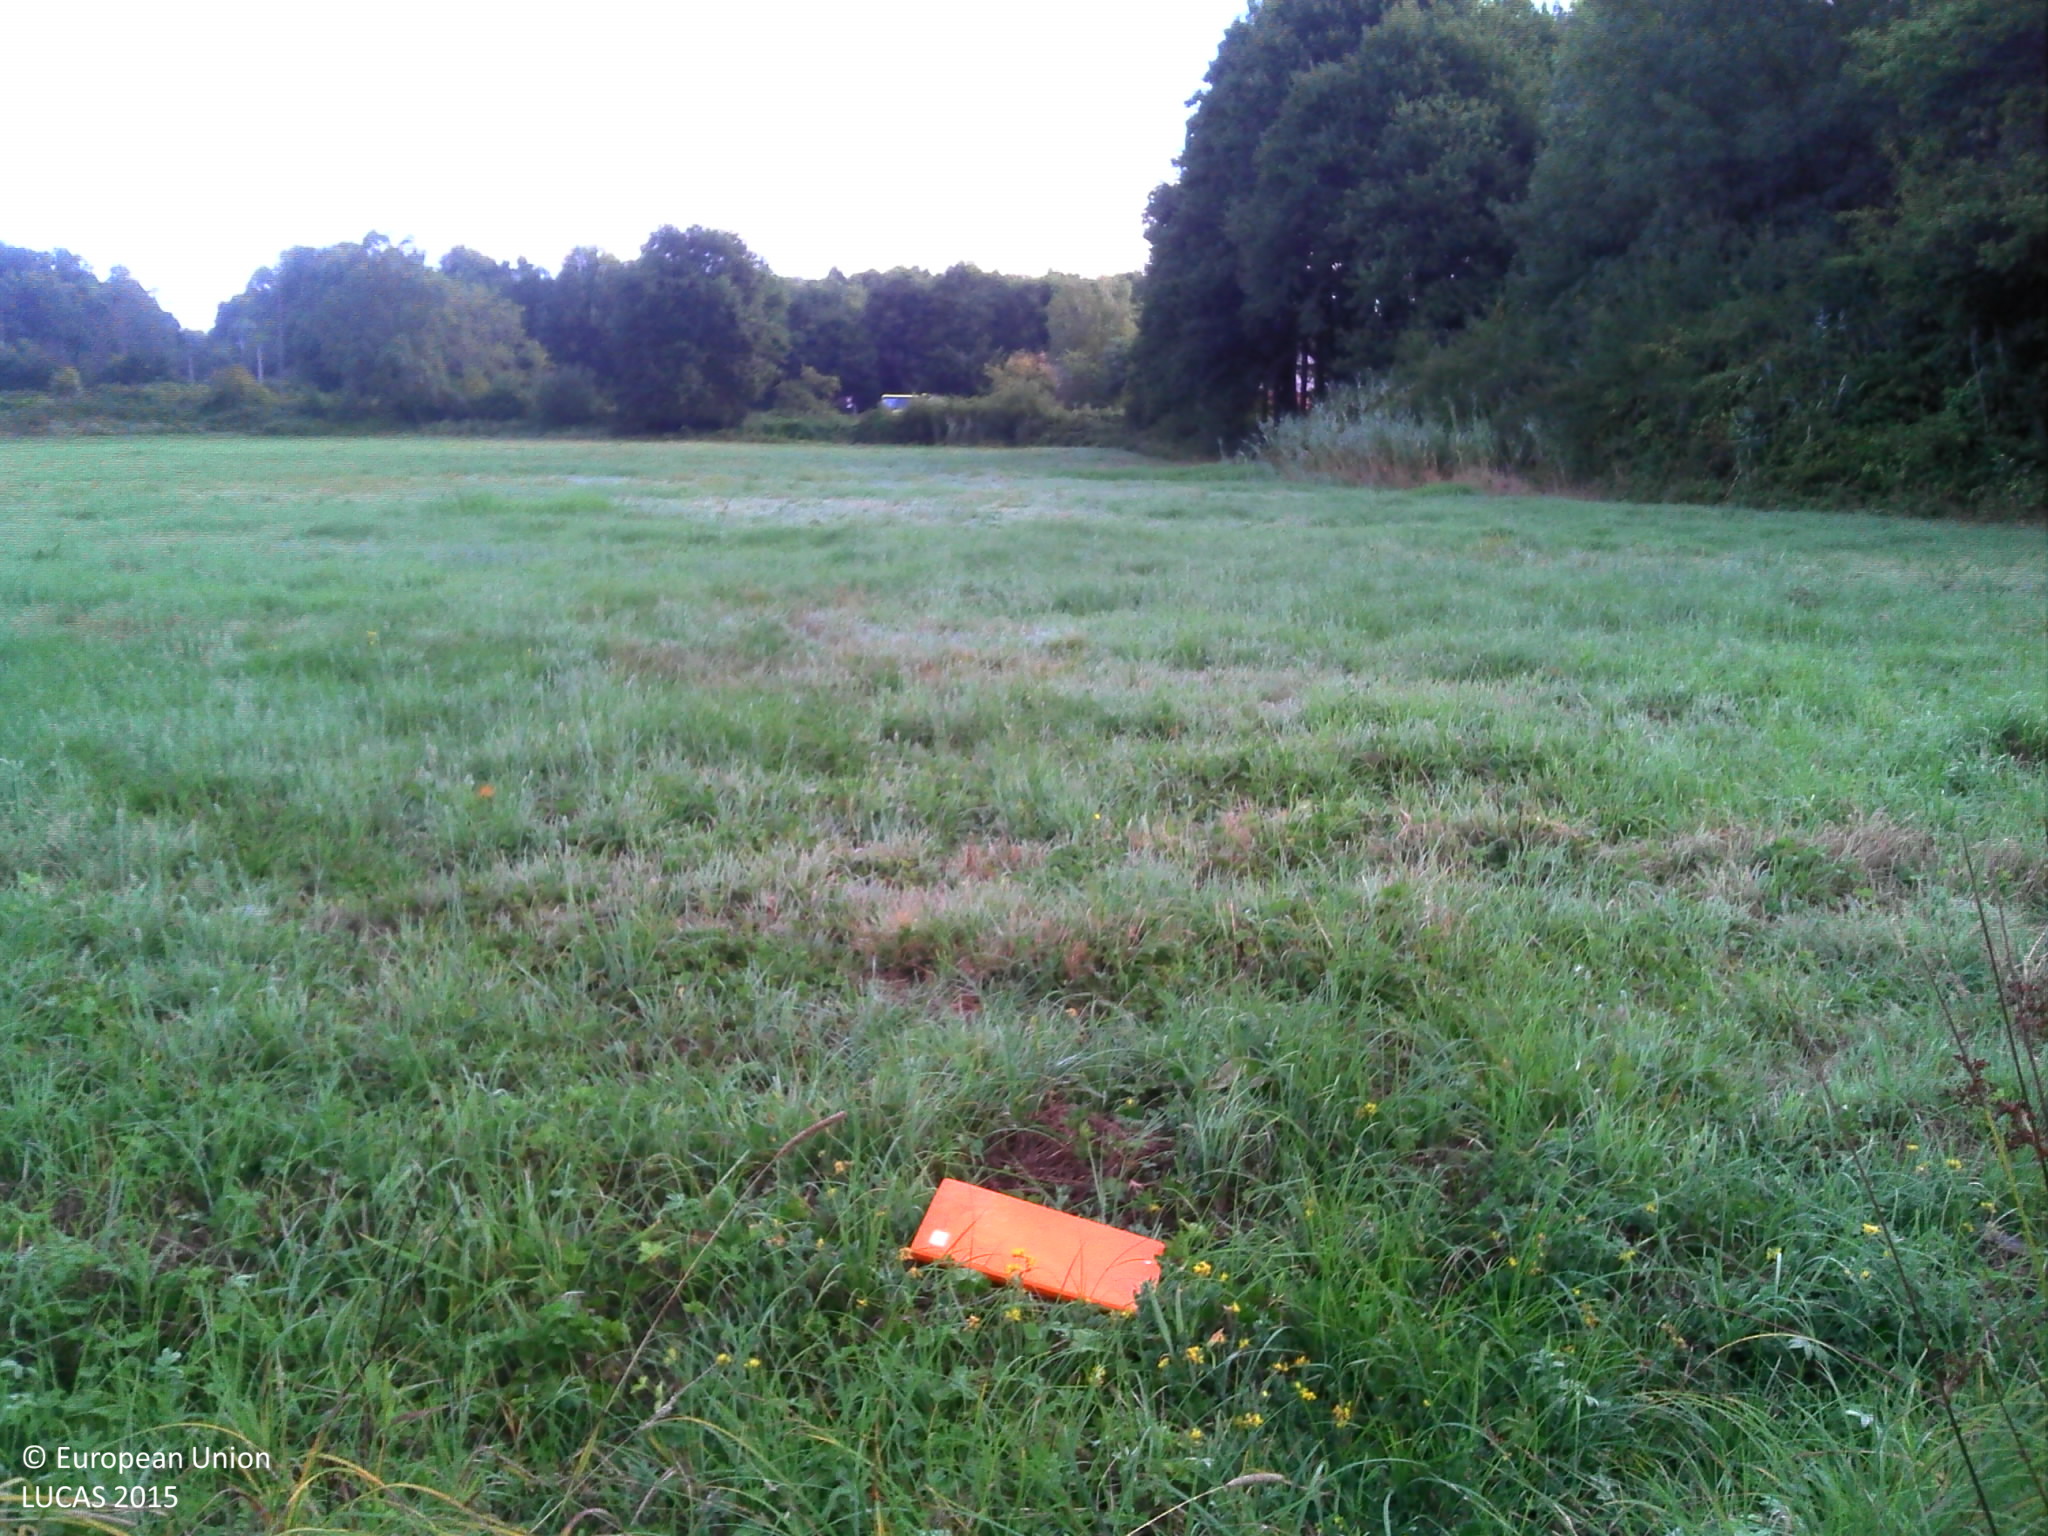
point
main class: Grassland
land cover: Grassland without tree/shrub cover
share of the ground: > 75 %
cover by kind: herbaceous plants 100 %
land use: Agriculture (excluding fallow land and kitchen gardens)
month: August
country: FR
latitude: 47.2030
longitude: 2.1629
